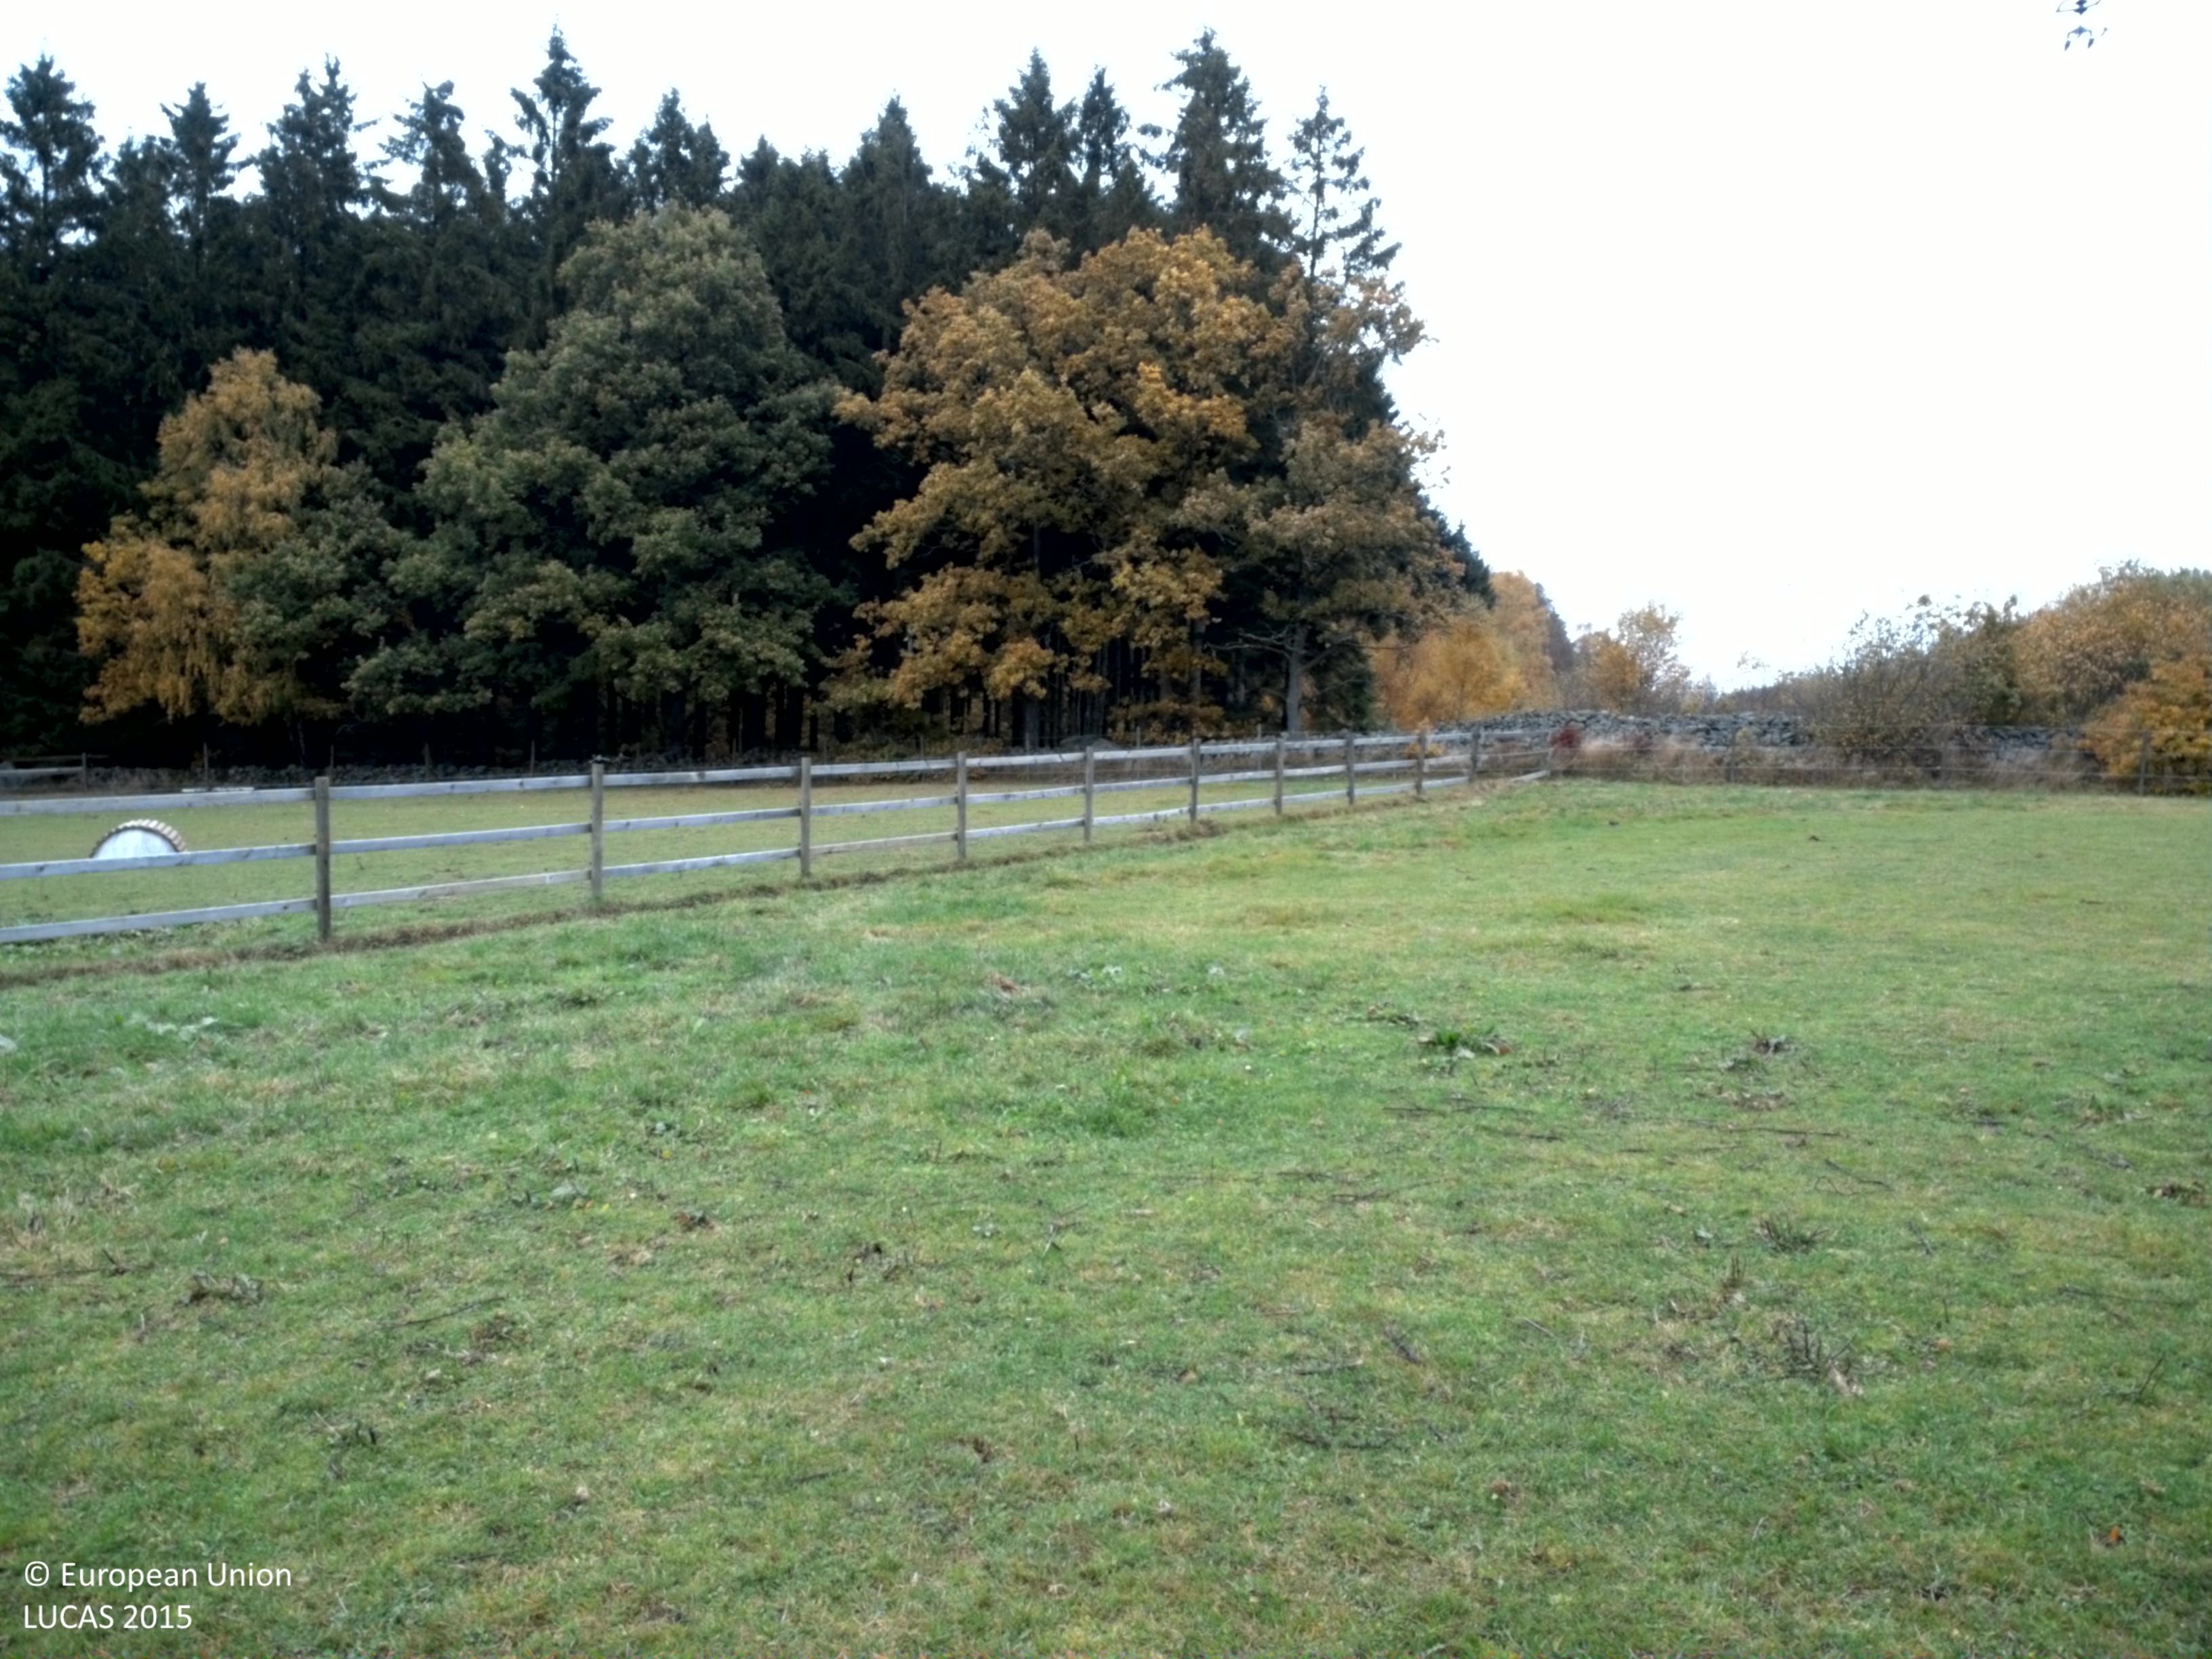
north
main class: Grassland
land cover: Grassland without tree/shrub cover
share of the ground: > 75 %
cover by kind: herbaceous plants 100 %
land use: Agriculture (excluding fallow land and kitchen gardens)
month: October
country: SE
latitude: 55.8828
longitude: 13.6907
